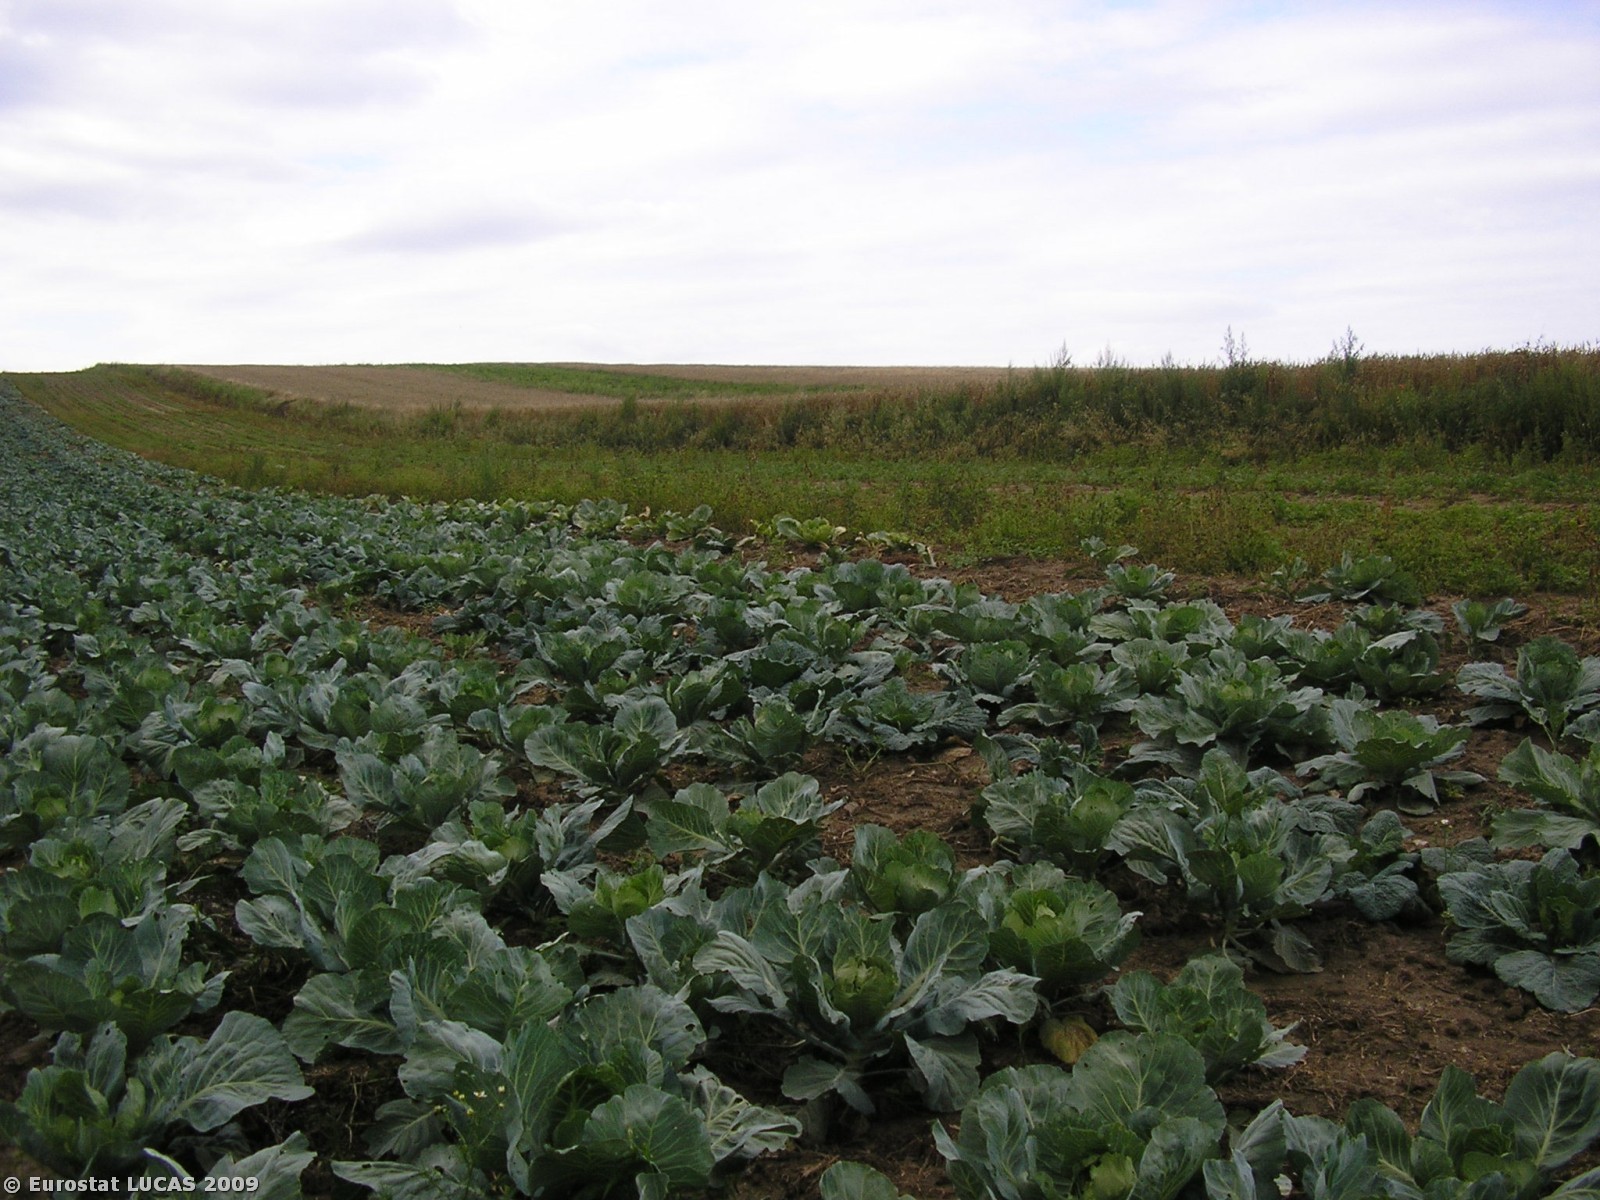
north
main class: Cropland
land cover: Other root crops
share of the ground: 50 - 75 %
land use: Agriculture (excluding fallow land and kitchen gardens)
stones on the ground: < 10 %
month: July
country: PL
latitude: 50.1414
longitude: 20.0089
